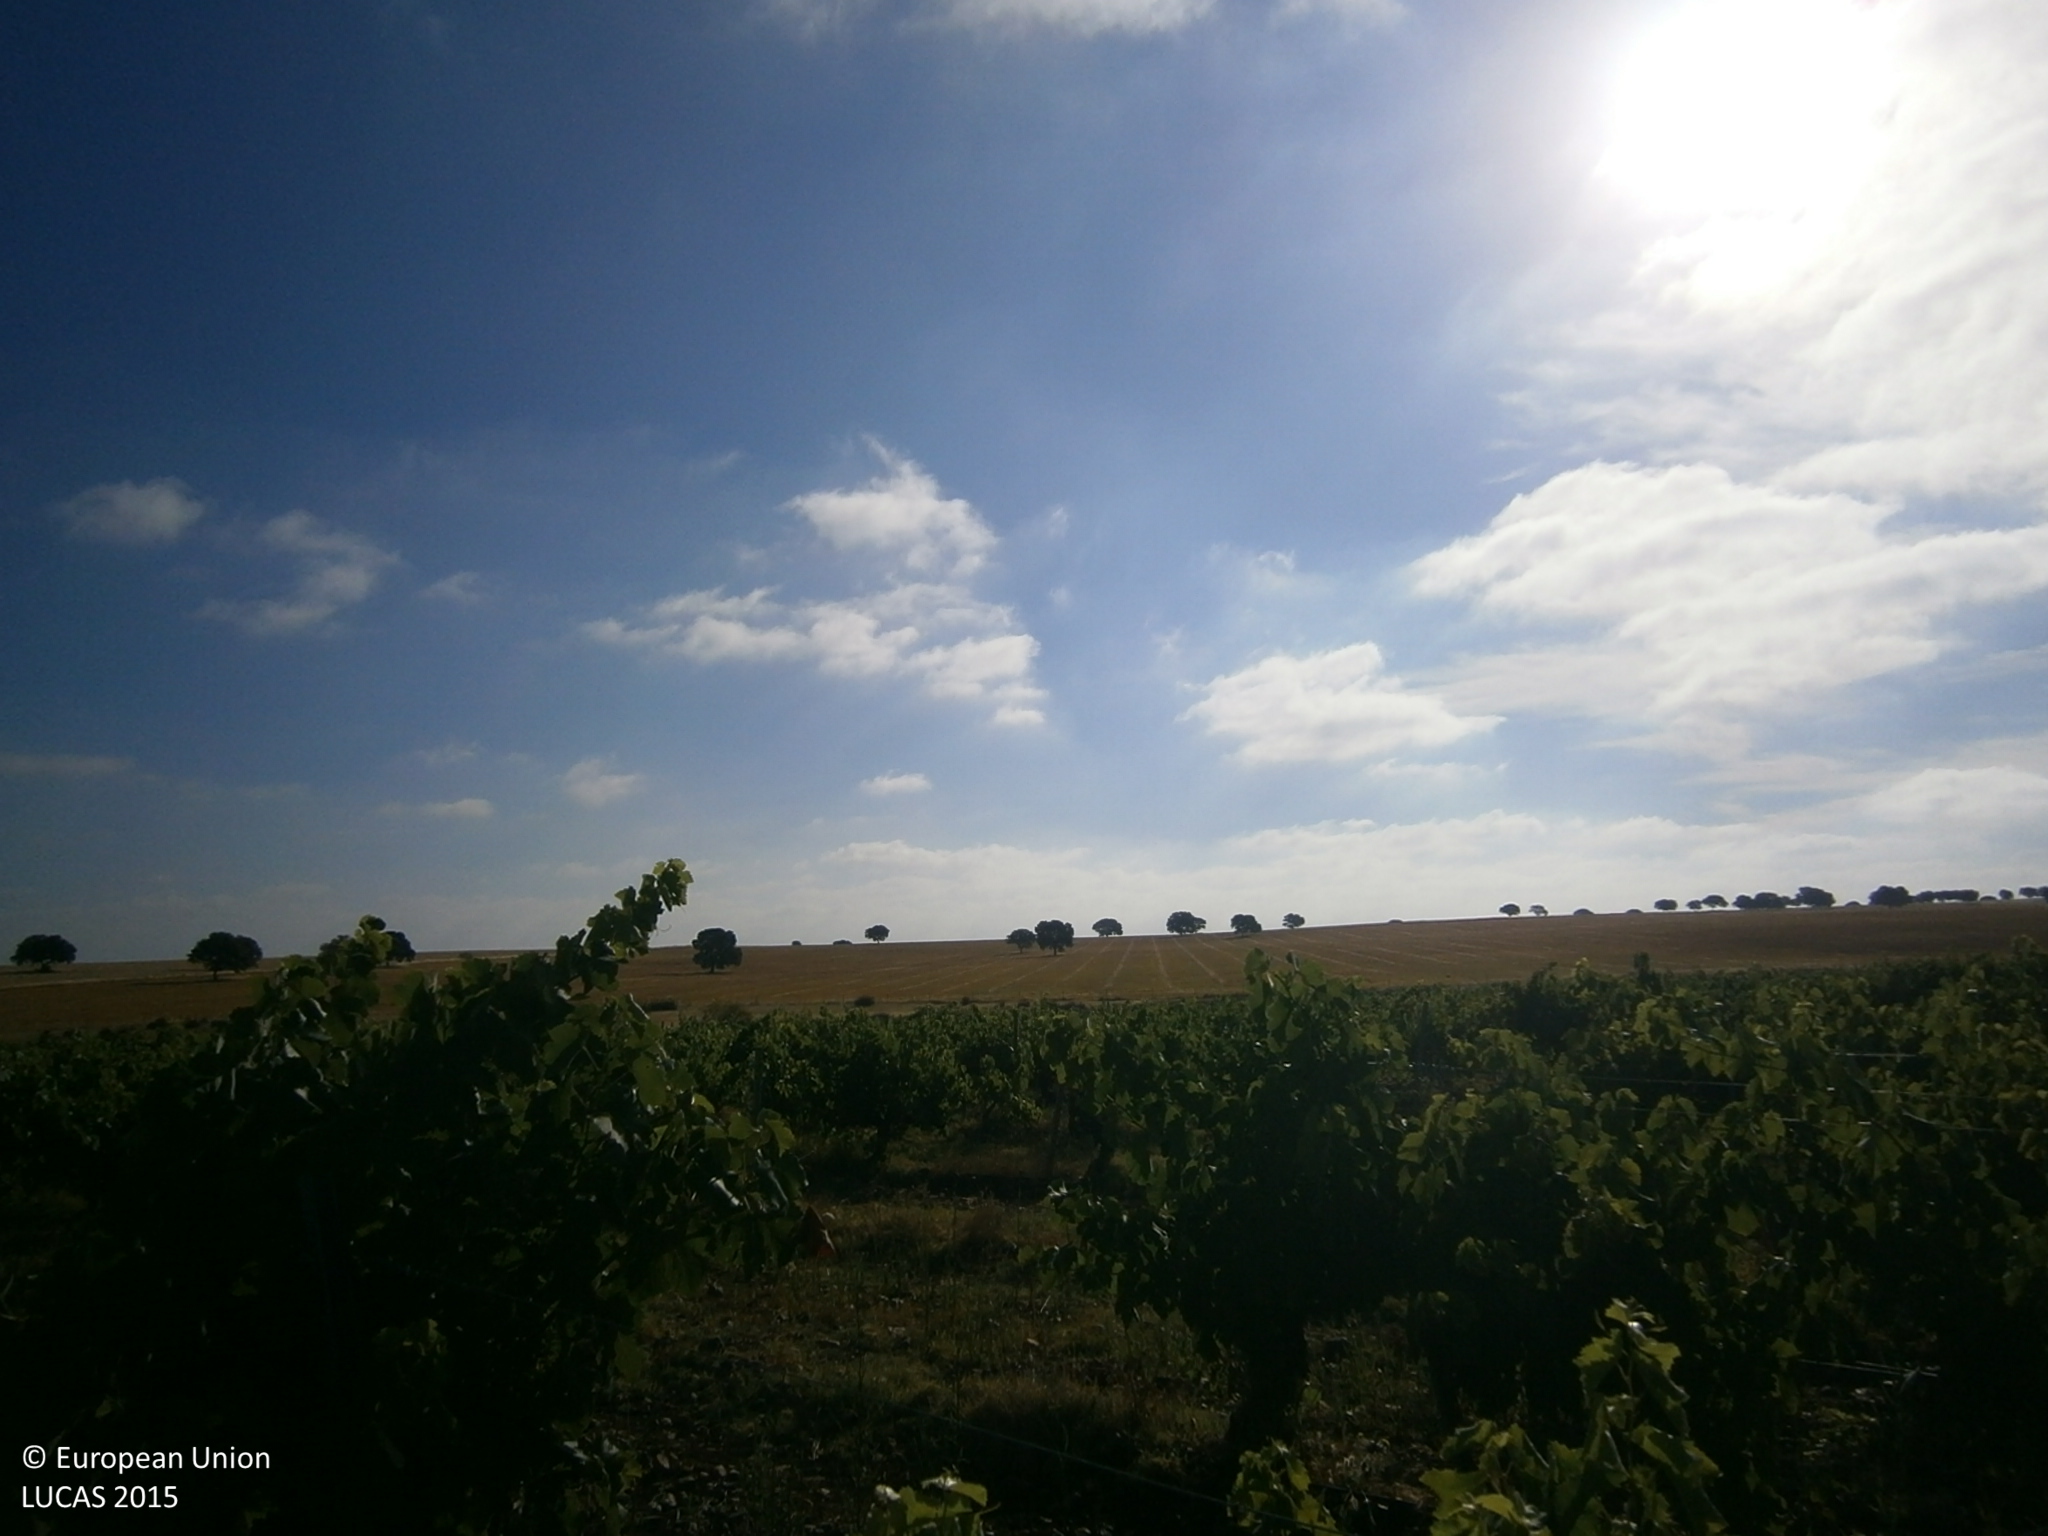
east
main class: Cropland
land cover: Vineyards
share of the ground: 25 - 50 %
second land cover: Spontaneously vegetated surfaces
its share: 25 - 50 %
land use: Agriculture (excluding fallow land and kitchen gardens)
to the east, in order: Vineyards; Spontaneously vegetated surfaces; Other bare soil; Fences; Spontaneously vegetated surfaces; Single bushes/trees; Temporary grasslands
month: June
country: ES
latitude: 38.7153
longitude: -6.7967
